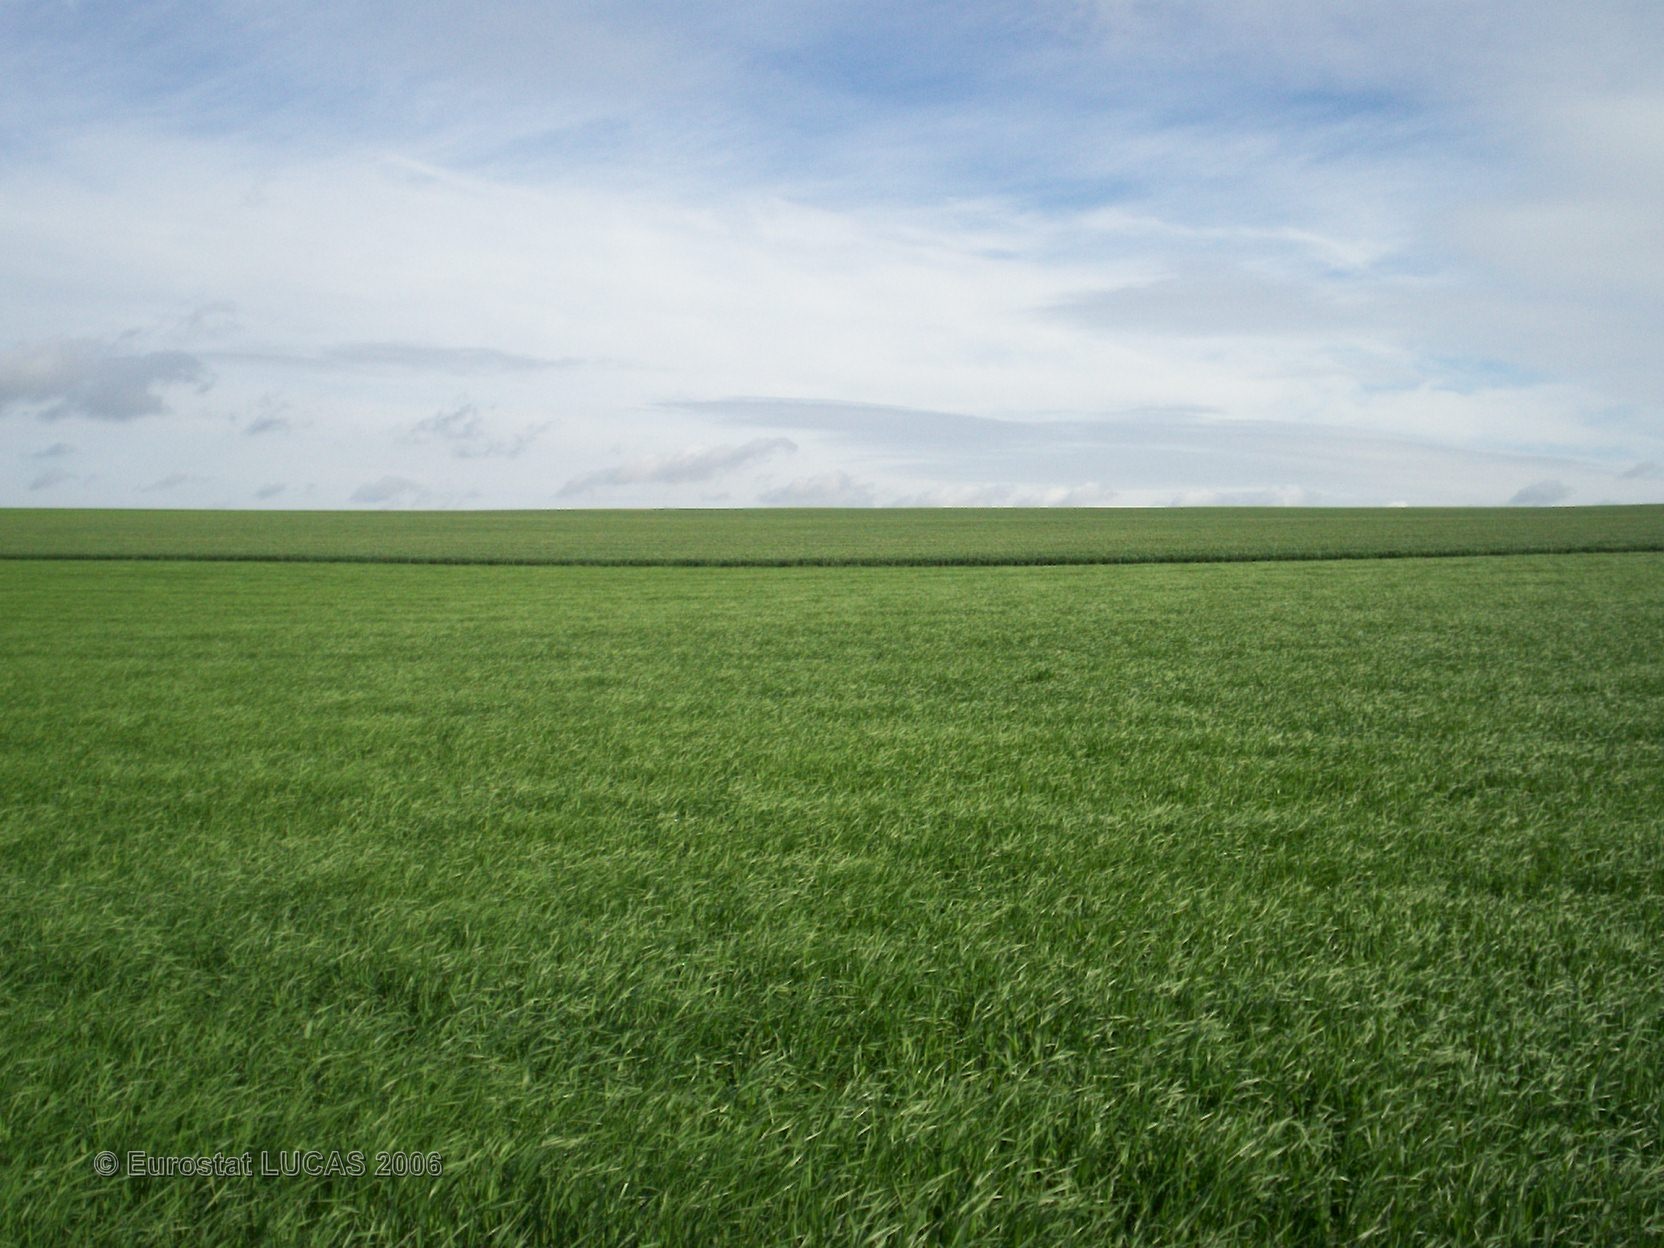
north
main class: Cropland
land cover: Barley
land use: Agriculture (excluding fallow land and kitchen gardens)
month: May
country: FR
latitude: 49.4343
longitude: 4.4113
